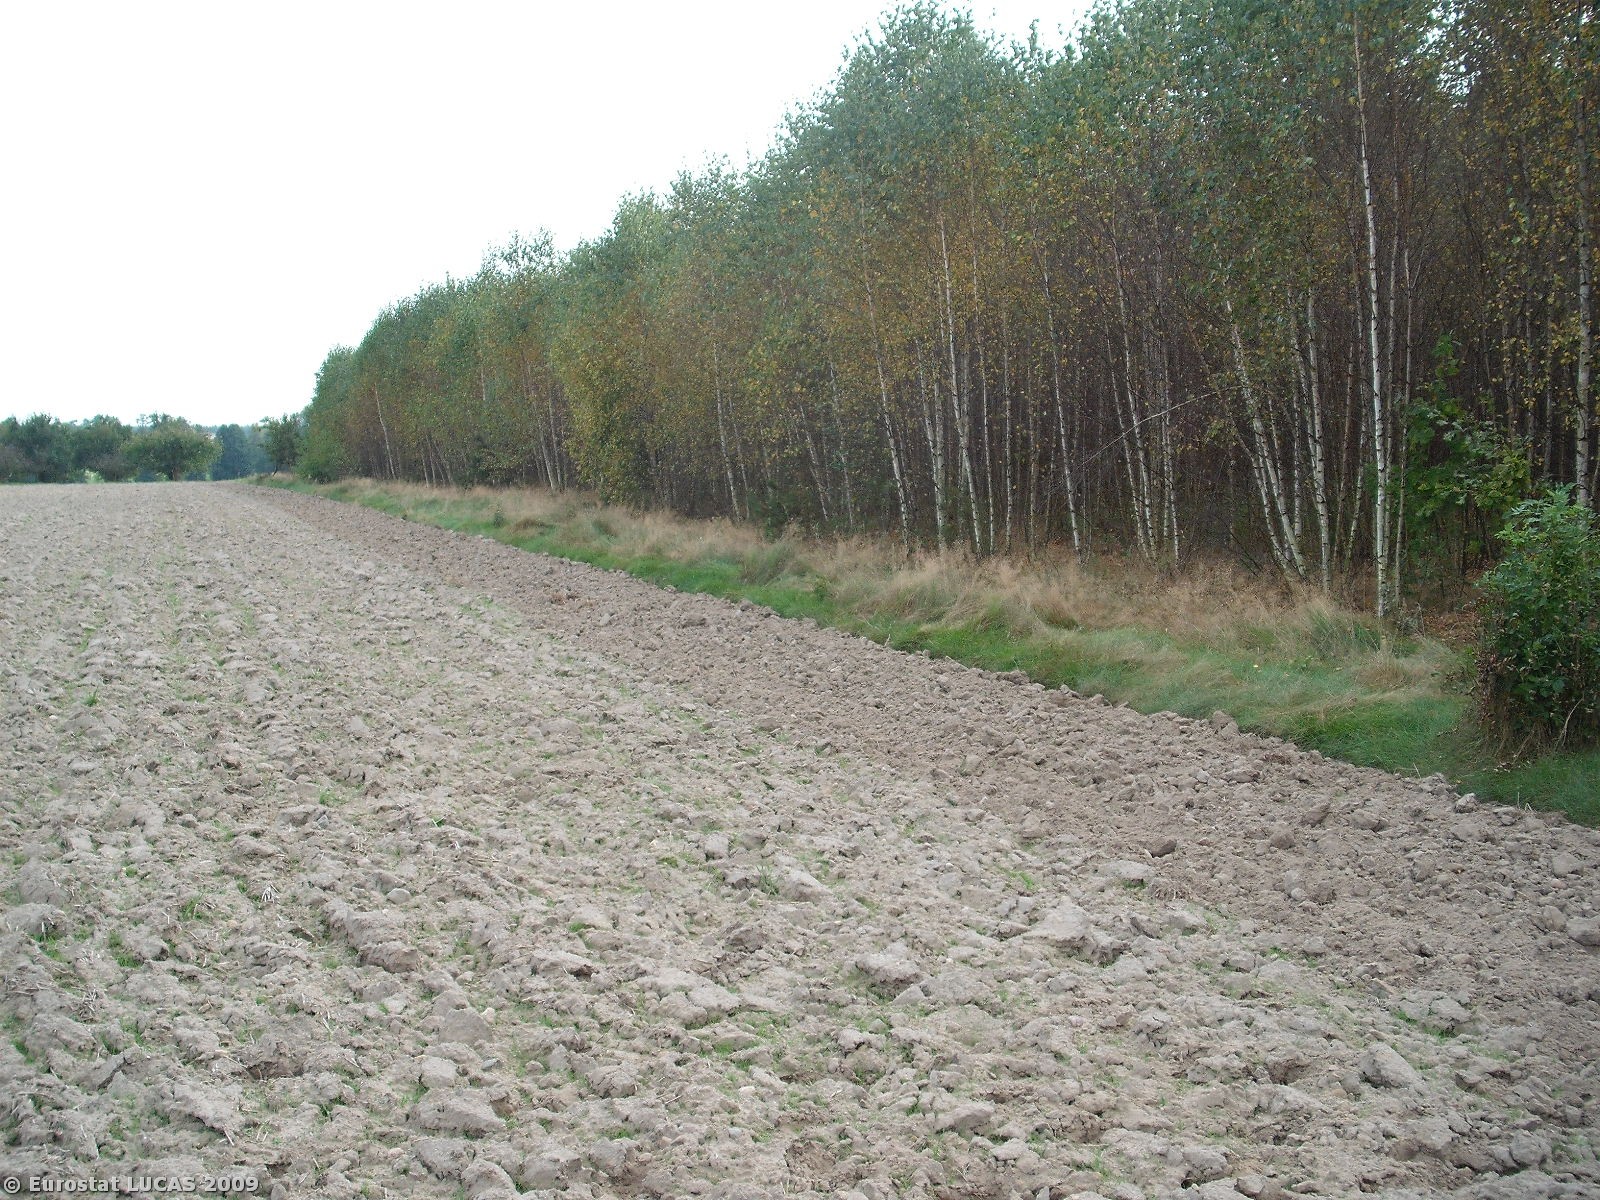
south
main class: Cropland
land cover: Rye
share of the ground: < 10 %
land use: Agriculture (excluding fallow land and kitchen gardens)
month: September
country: PL
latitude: 52.0298
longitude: 20.7839
